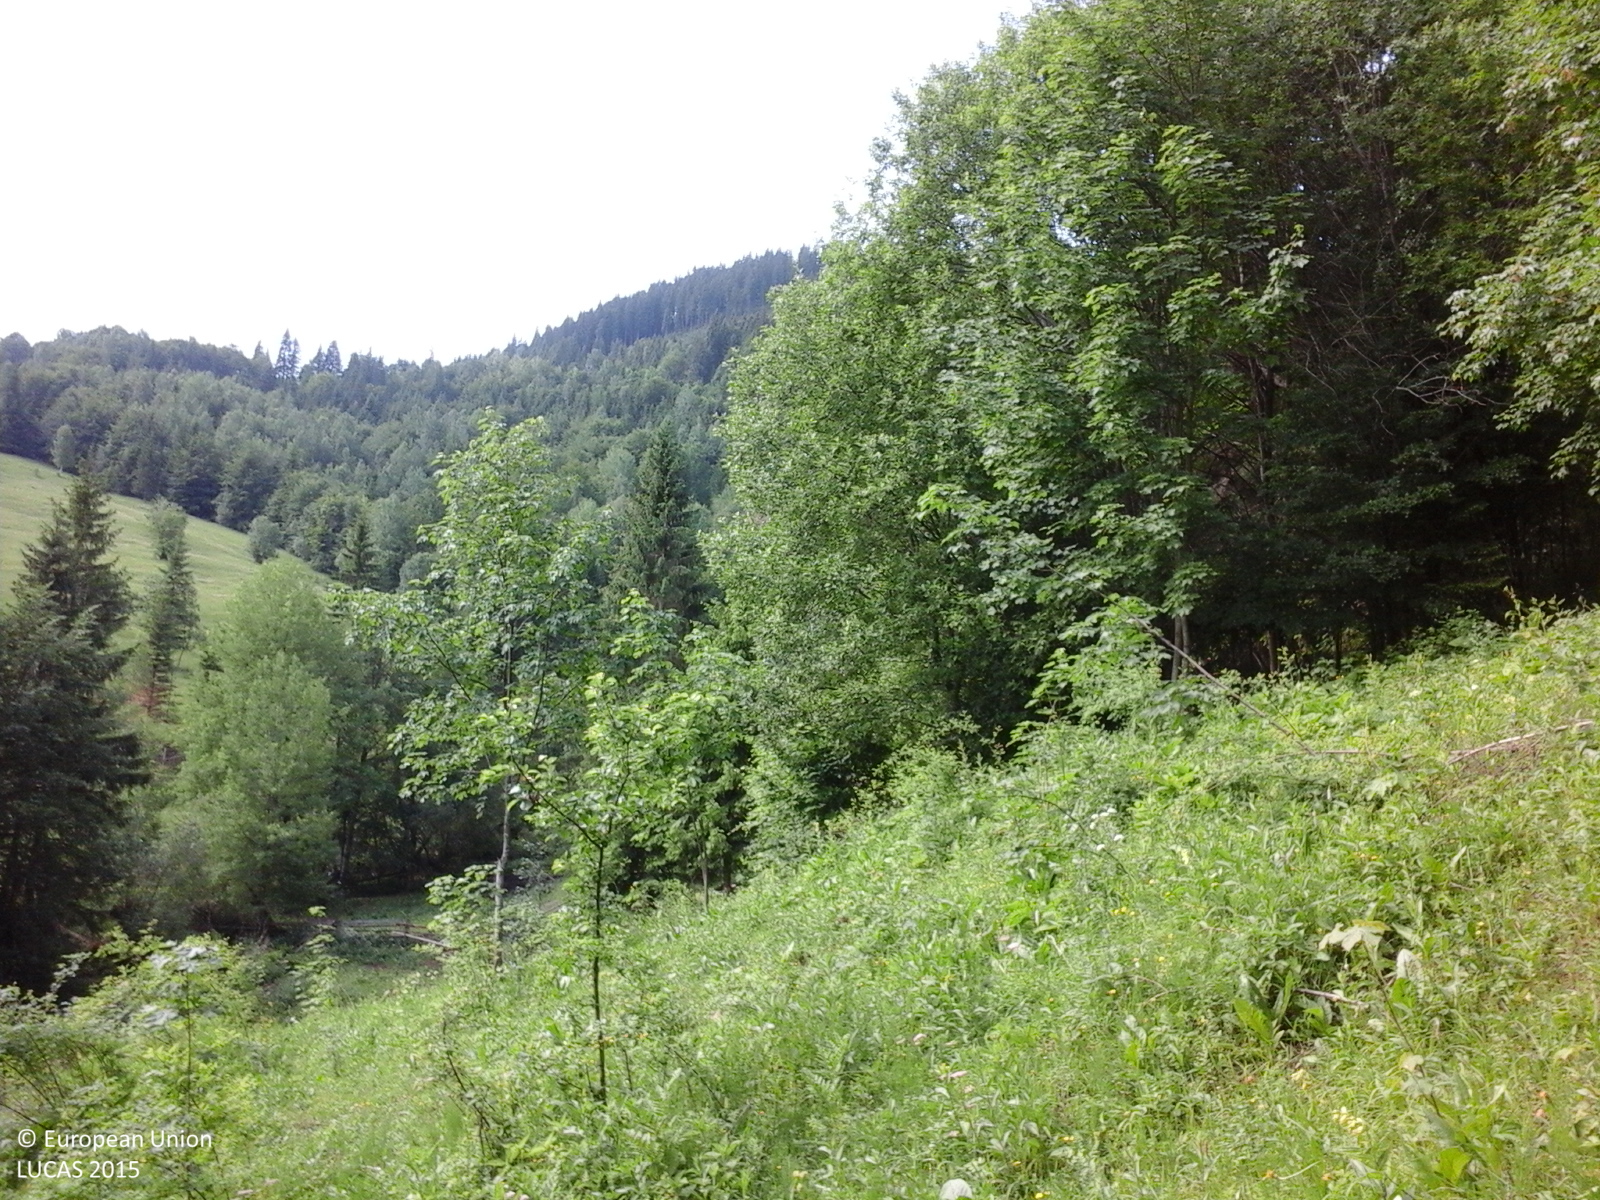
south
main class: Woodland
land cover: Broadleaved woodland
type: mountainous beech forest
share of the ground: > 75 %
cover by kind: broadleaved forest trees 80 %, coniferous forest trees 20 %
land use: Forestry
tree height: > 5 m
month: June
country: RO
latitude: 46.7900
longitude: 25.9871
